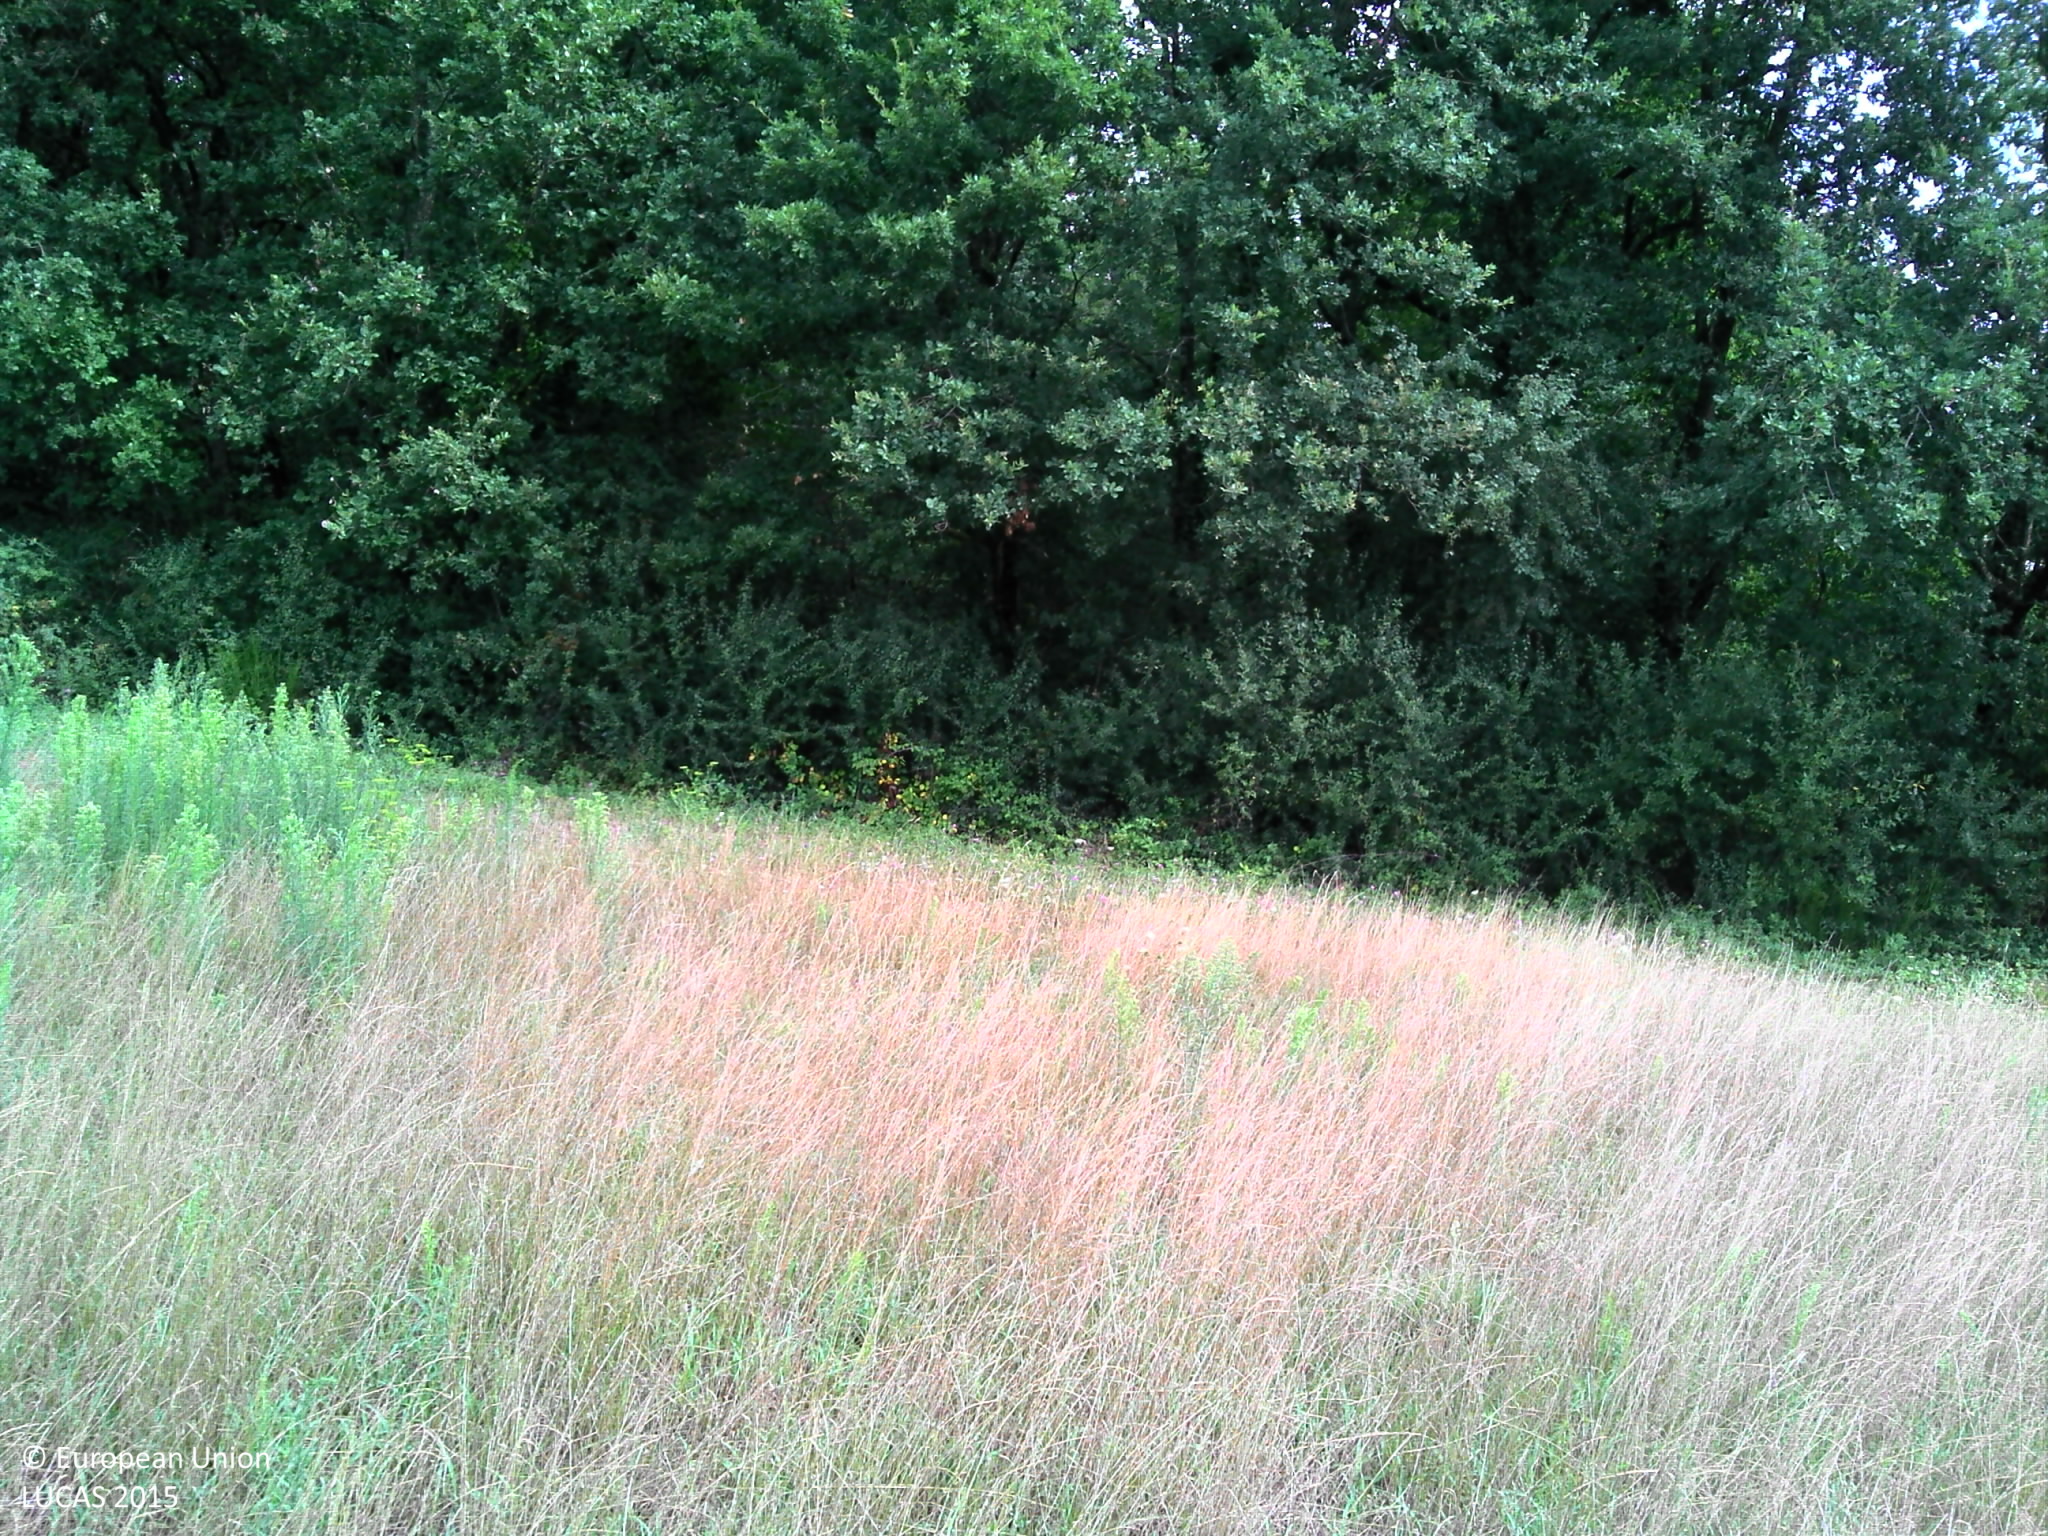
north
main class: Grassland
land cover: Grassland without tree/shrub cover
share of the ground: > 75 %
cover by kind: herbaceous plants 100 %
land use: Agriculture (excluding fallow land and kitchen gardens)
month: August
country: FR
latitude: 44.0439
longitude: 1.5768
